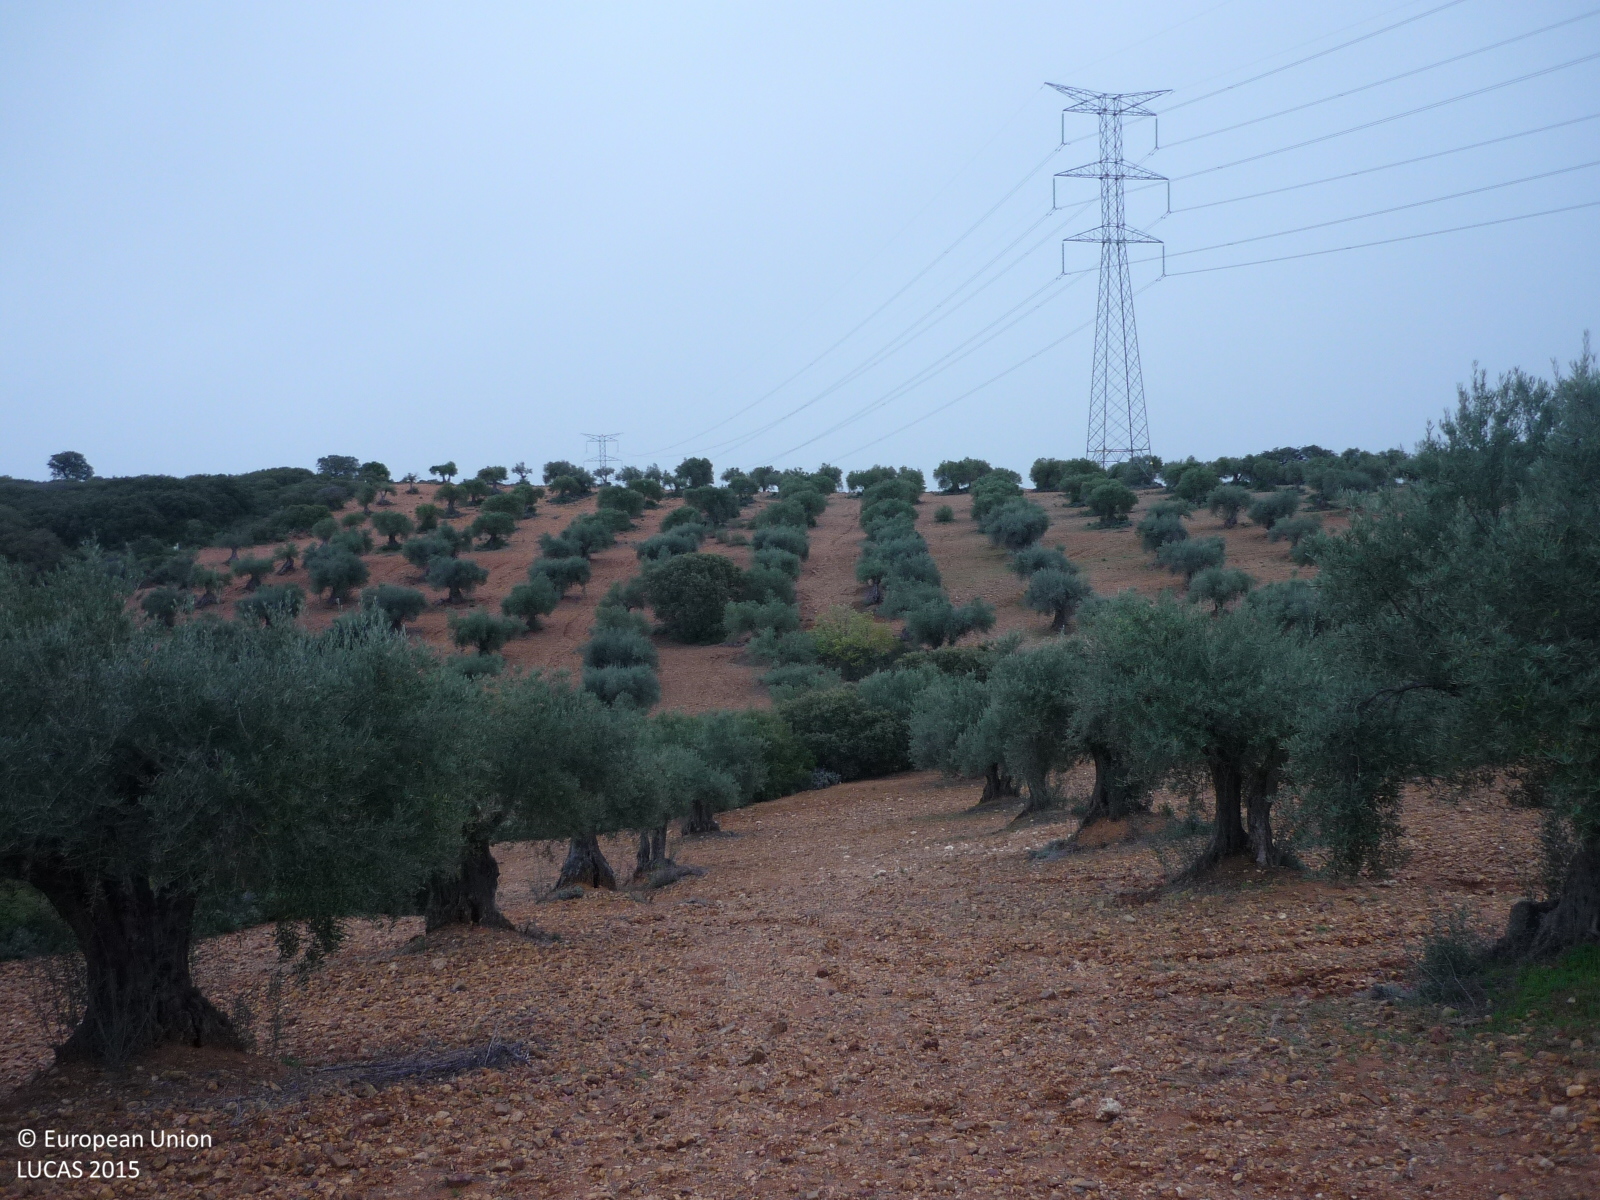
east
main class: Cropland
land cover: Olive groves
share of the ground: 10 - 25 %
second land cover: Other bare soil
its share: > 75 %
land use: Agriculture (excluding fallow land and kitchen gardens)
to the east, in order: Olive groves; Other bare soil; Shrubland without tree cover; Olive groves; Shrubland without tree cover; Tracks; Shrubland without tree cover
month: April
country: ES
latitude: 40.3721
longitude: -3.3766
